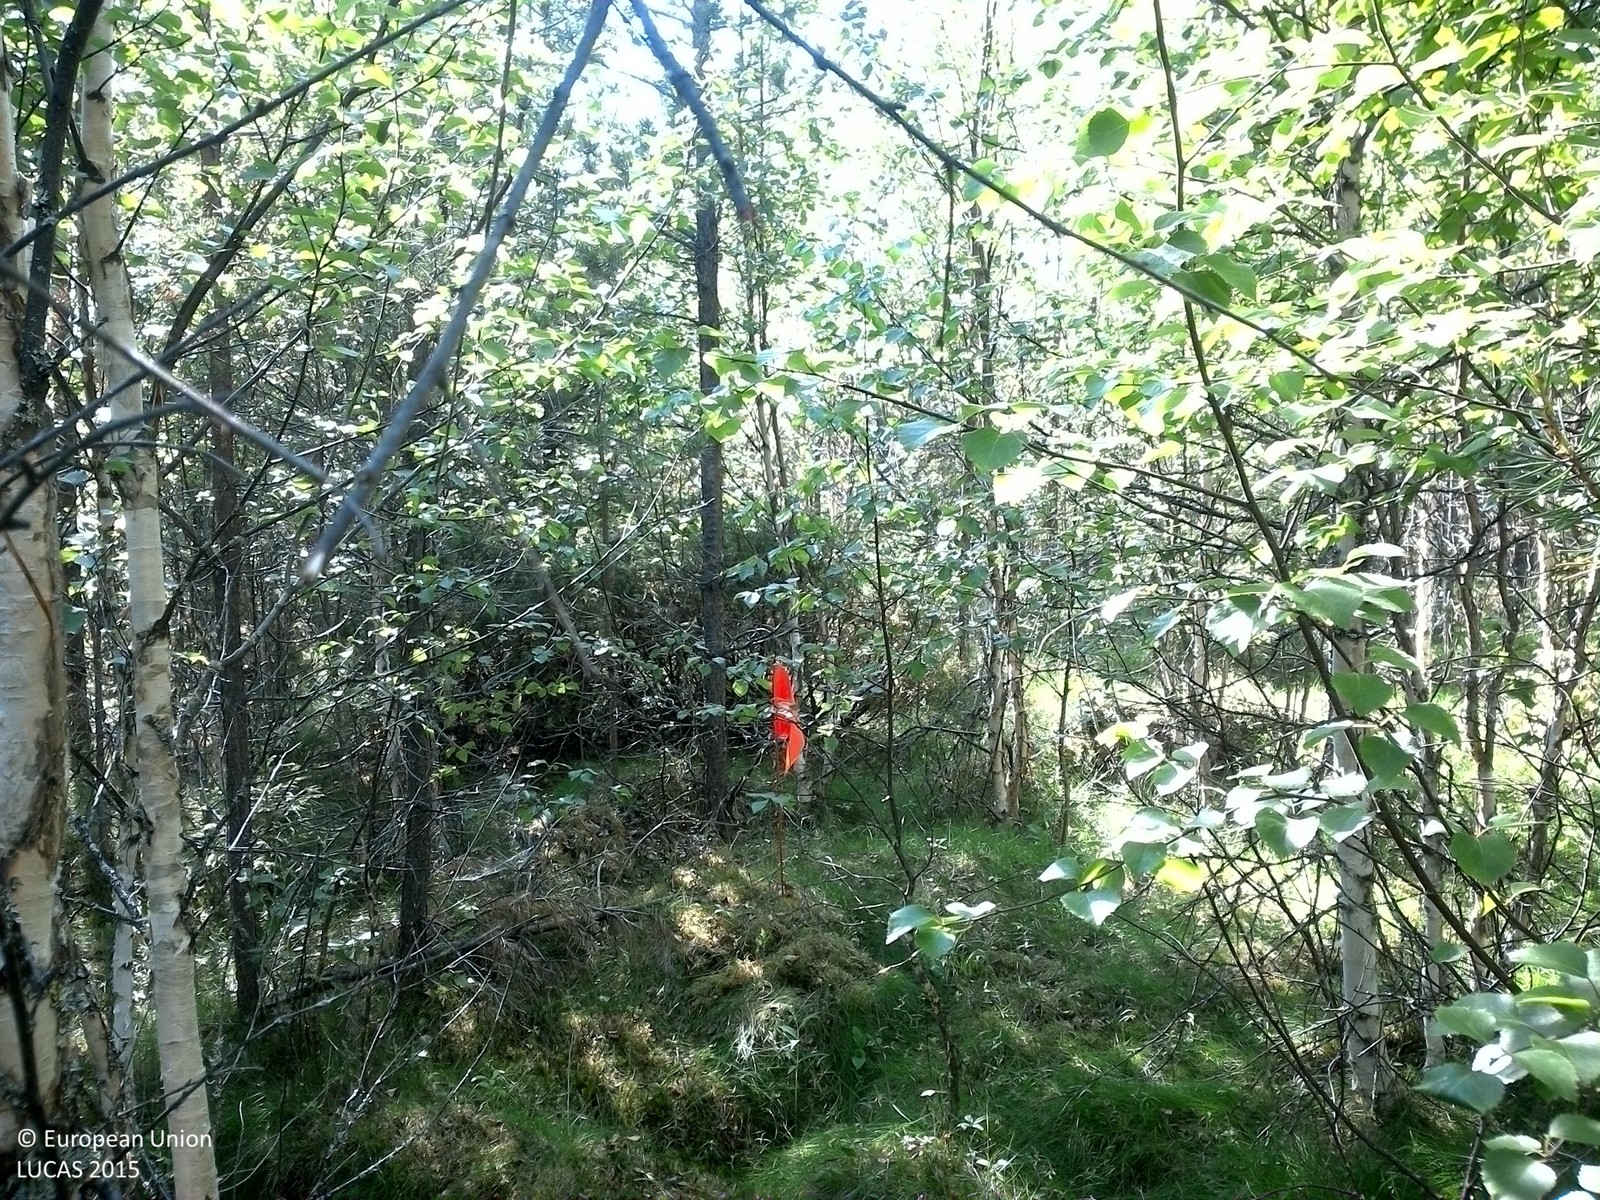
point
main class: Woodland
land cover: Pine dominated mixed woodland
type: boreal forest
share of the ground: > 75 %
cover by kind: coniferous forest trees 45 %, broadleaved forest trees 40 %, lichens and mosses 10 %, herbaceous plants 5 %
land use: Forestry
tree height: < 5 m
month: July
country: SE
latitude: 63.5586
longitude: 17.6832
